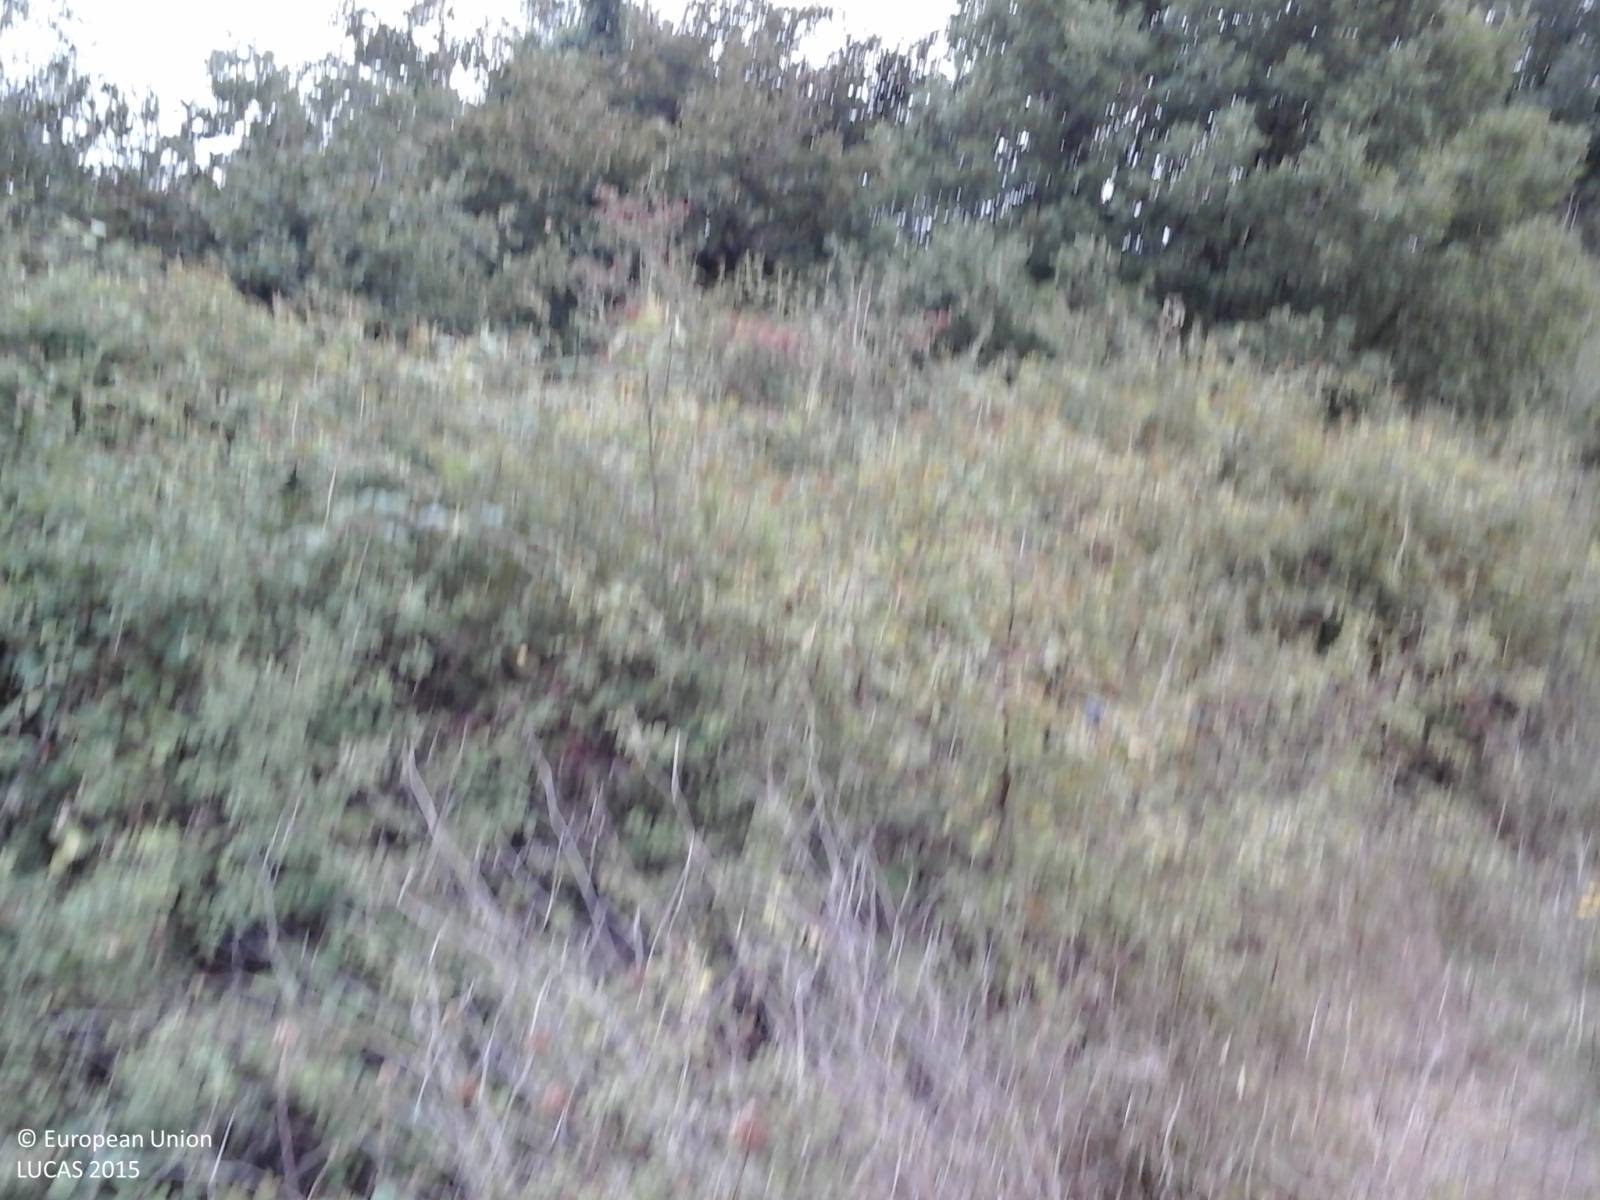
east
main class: Woodland
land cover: Broadleaved woodland
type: thermophilous deciduous forest
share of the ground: > 75 %
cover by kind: broadleaved forest trees 100 %
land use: Forestry
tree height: > 5 m
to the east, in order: Broadleaved woodland; Ditches and canals; Broadleaved woodland; Grassland without tree/shrub cover
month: September
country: IT
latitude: 42.2990
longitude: 12.4539
